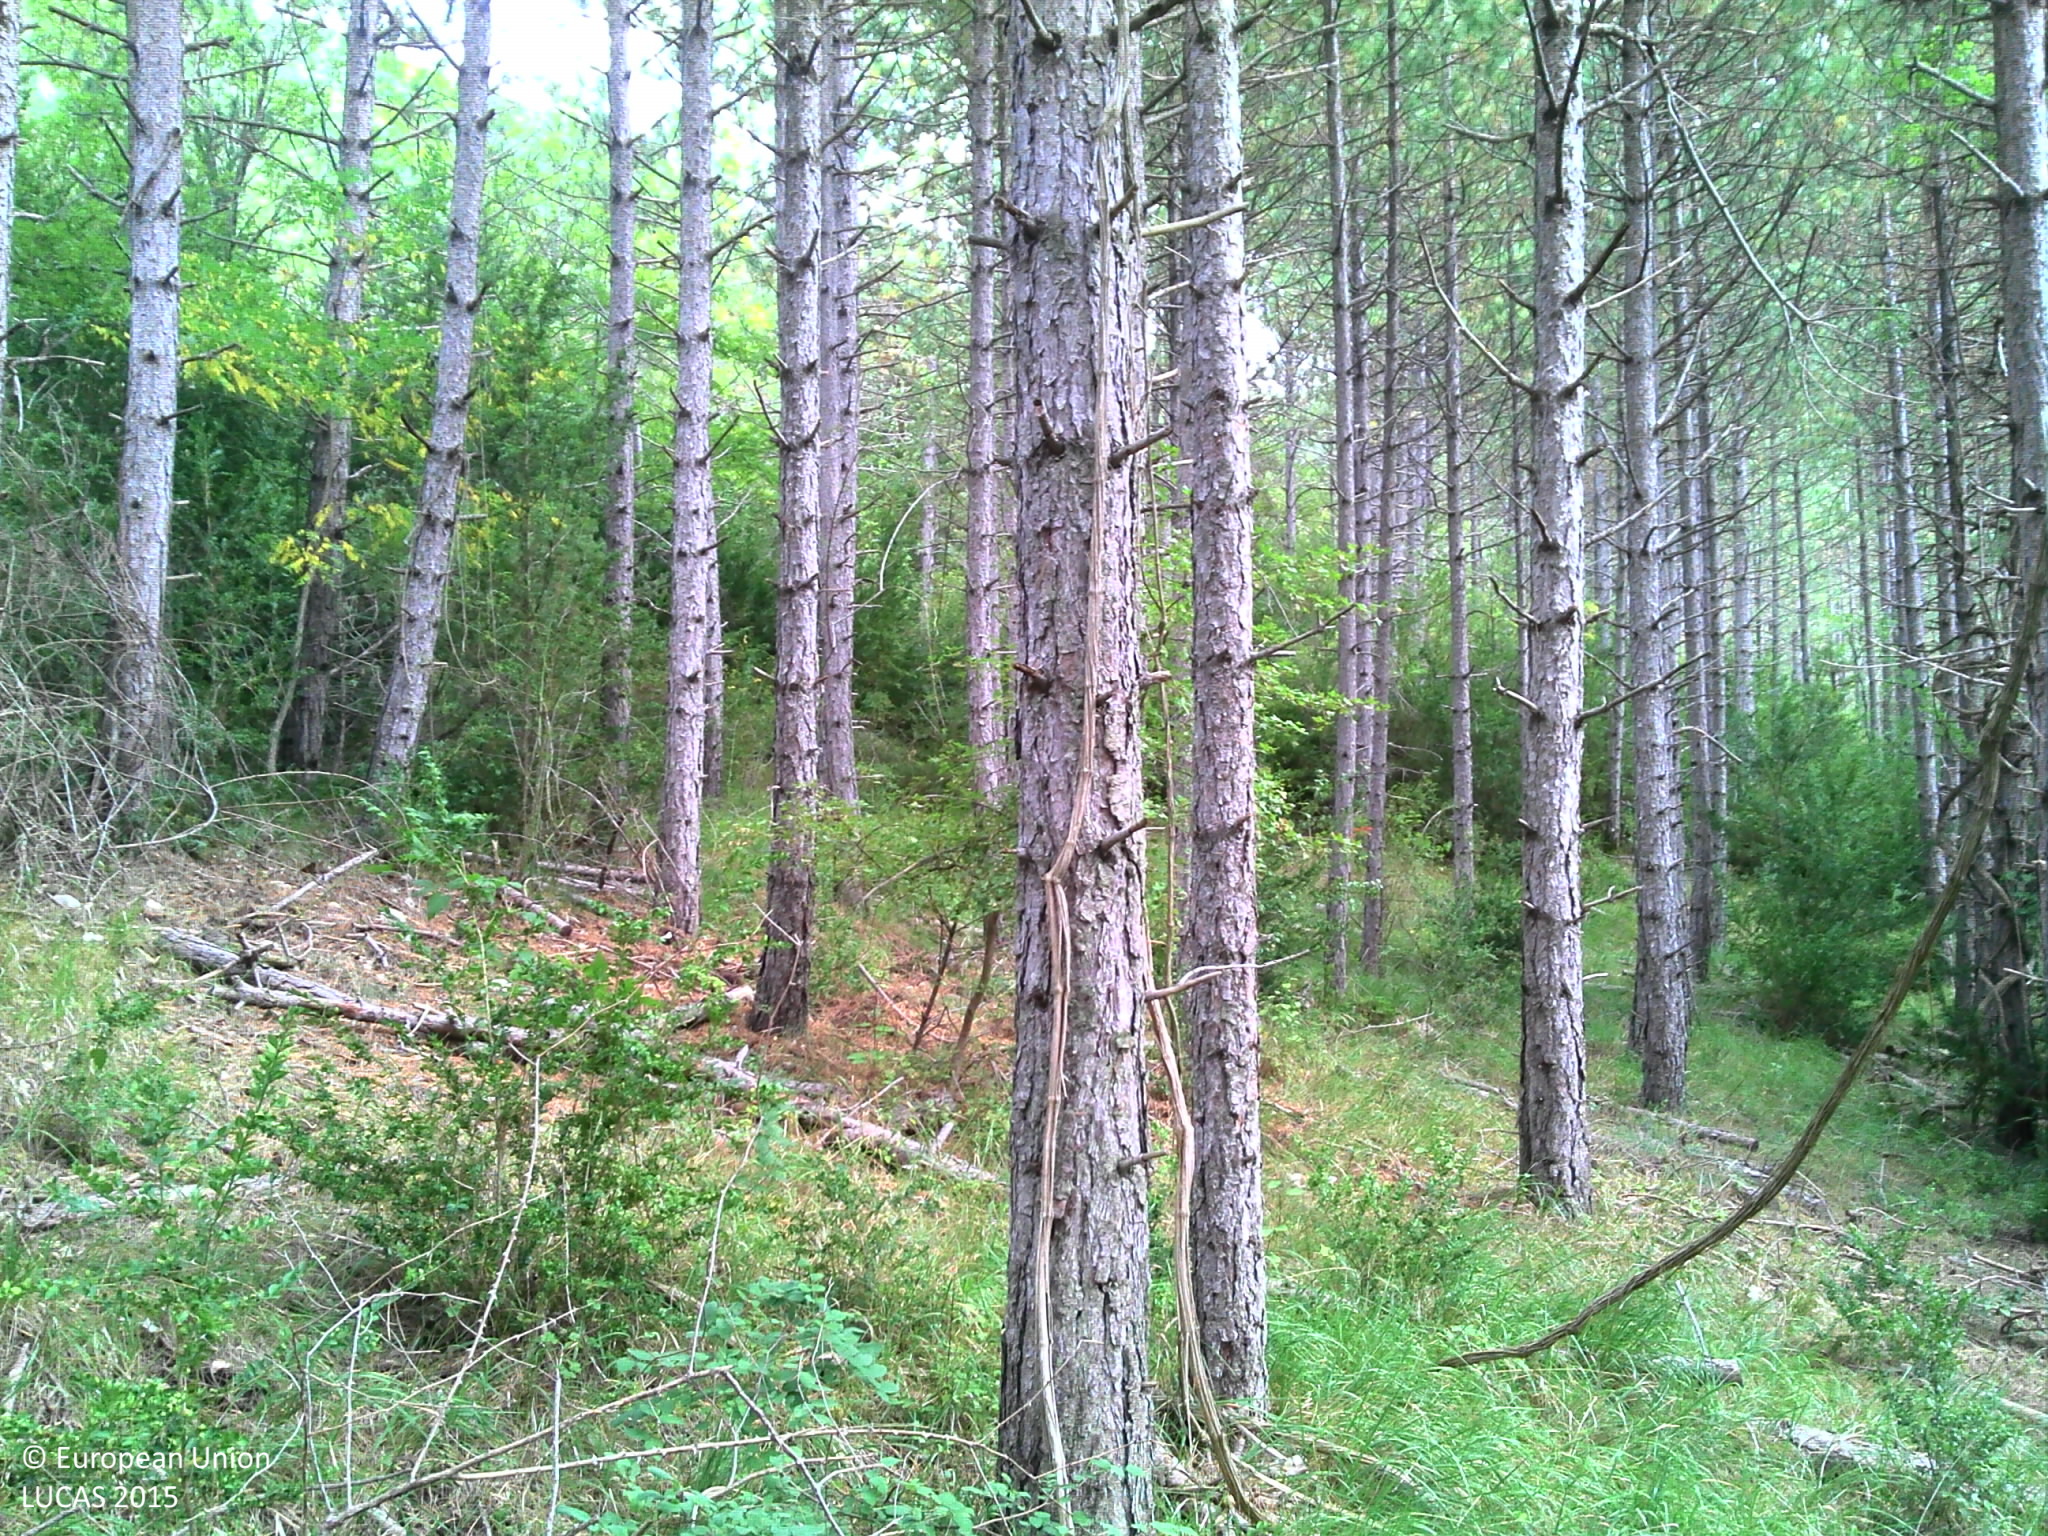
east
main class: Woodland
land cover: Pine dominated coniferous woodland
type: exotic forest
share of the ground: > 75 %
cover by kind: coniferous forest trees 80 %, herbaceous plants 15 %, shrubs 5 %
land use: Forestry
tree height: > 5 m
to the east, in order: Pine dominated coniferous woodland; Tracks; Pine dominated coniferous woodland; Tracks
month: September
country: FR
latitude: 44.4716
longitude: 5.5444
